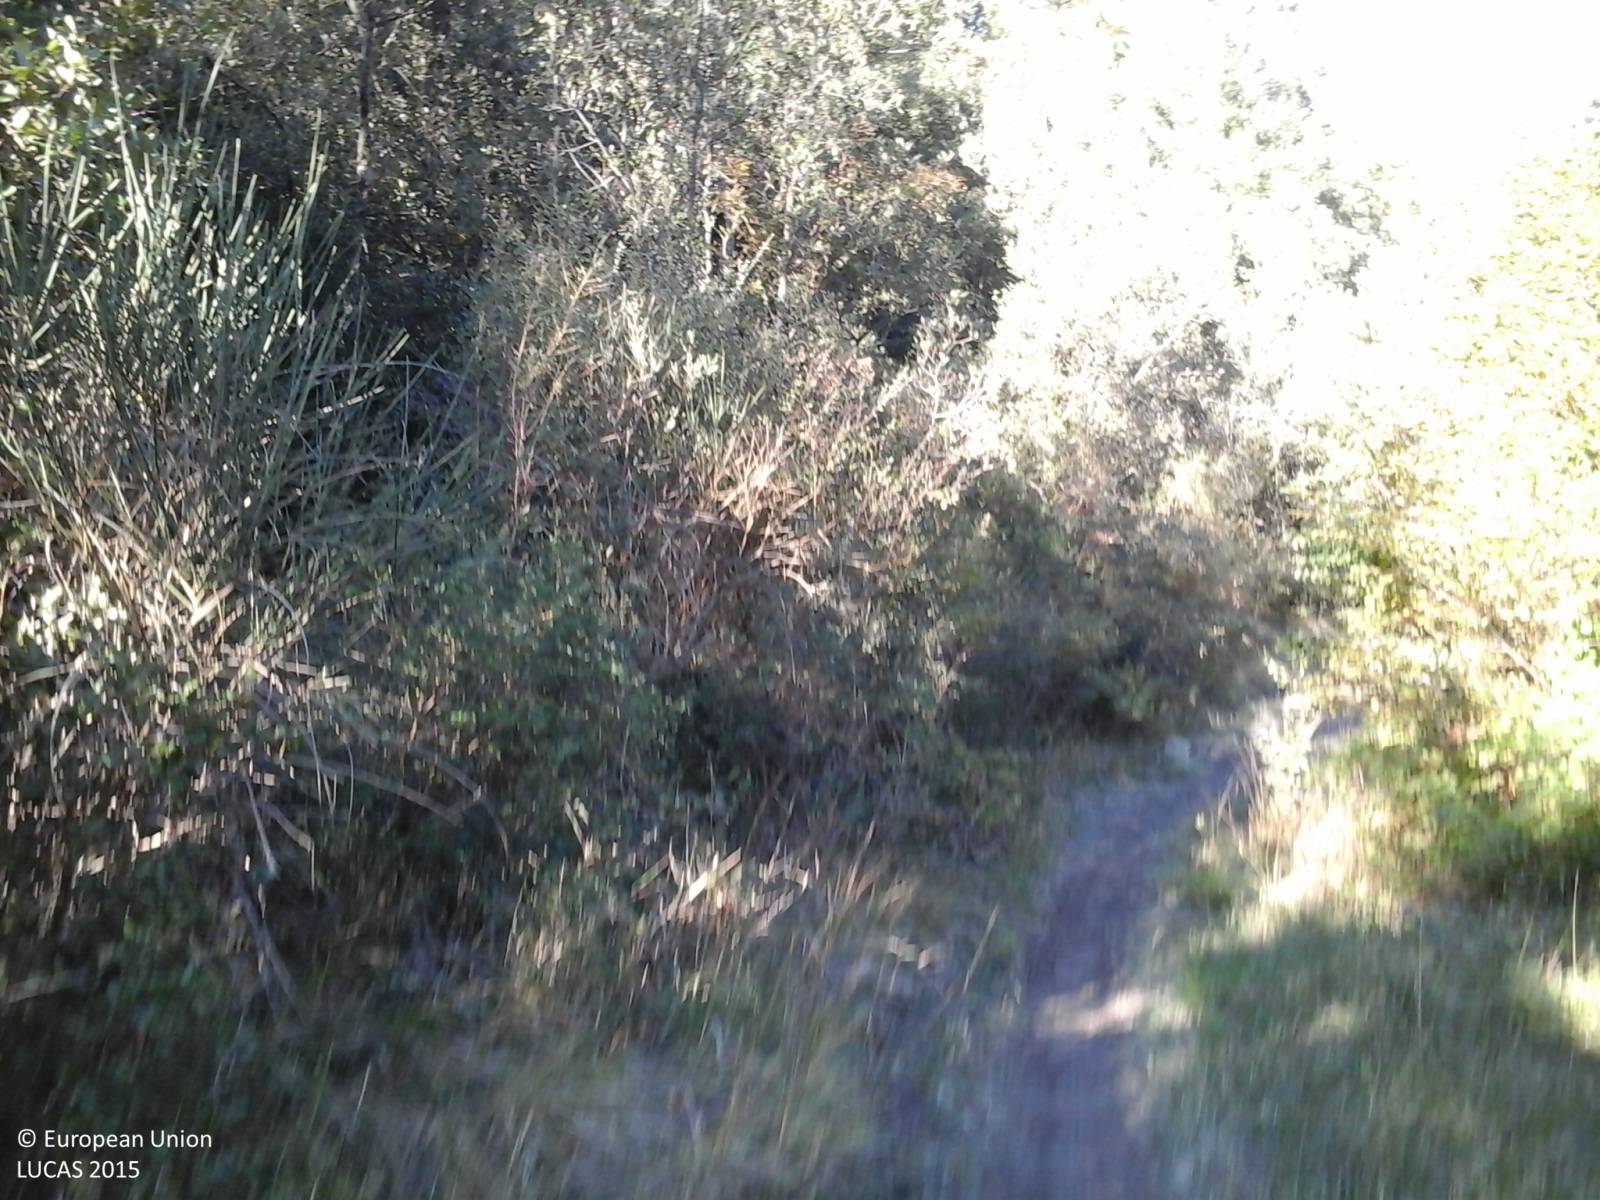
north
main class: Woodland
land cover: Broadleaved woodland
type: thermophilous deciduous forest
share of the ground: > 75 %
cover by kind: broadleaved forest trees 80 %, shrubs 20 %
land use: Forestry
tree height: > 5 m
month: October
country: IT
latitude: 43.3927
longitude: 10.5786
